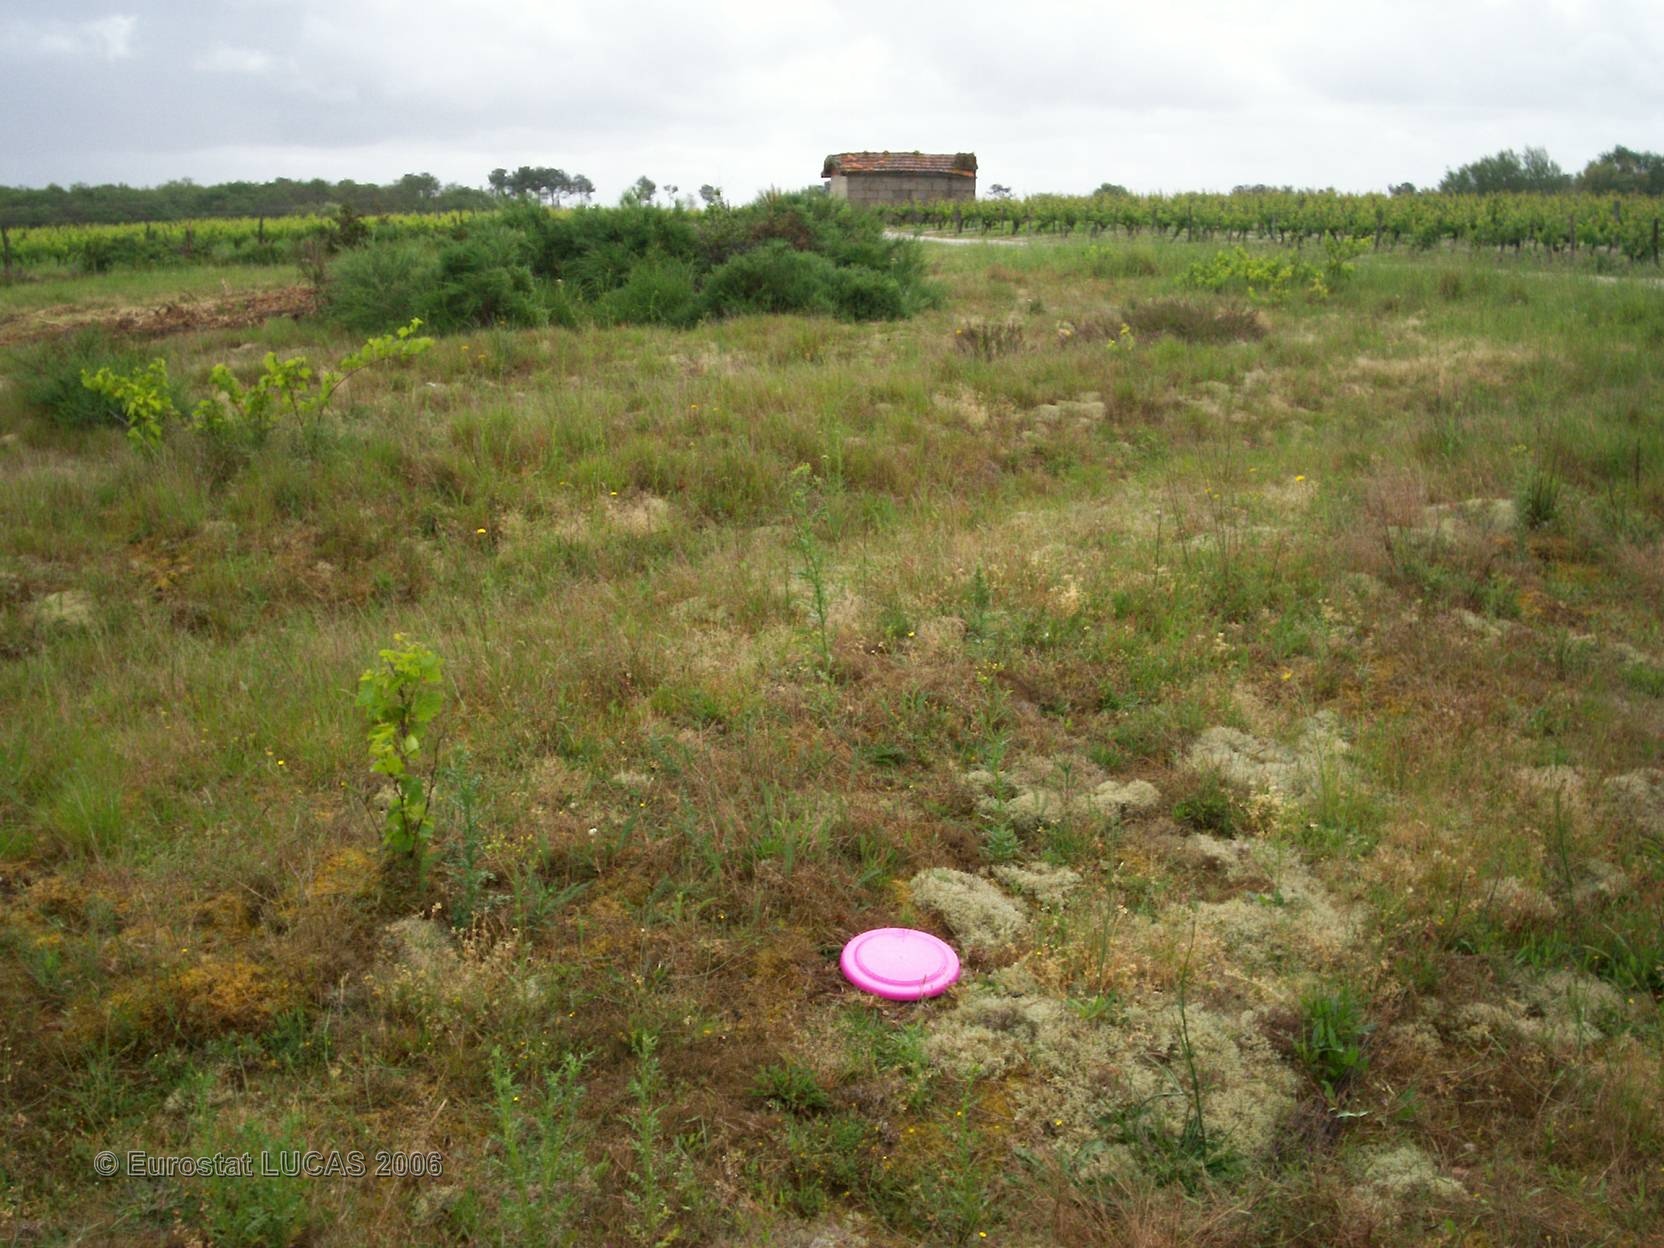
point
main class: Grassland
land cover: Grassland with sparse tree/shrub cover
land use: Unused
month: May
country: FR
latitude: 45.4156
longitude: -1.0288
